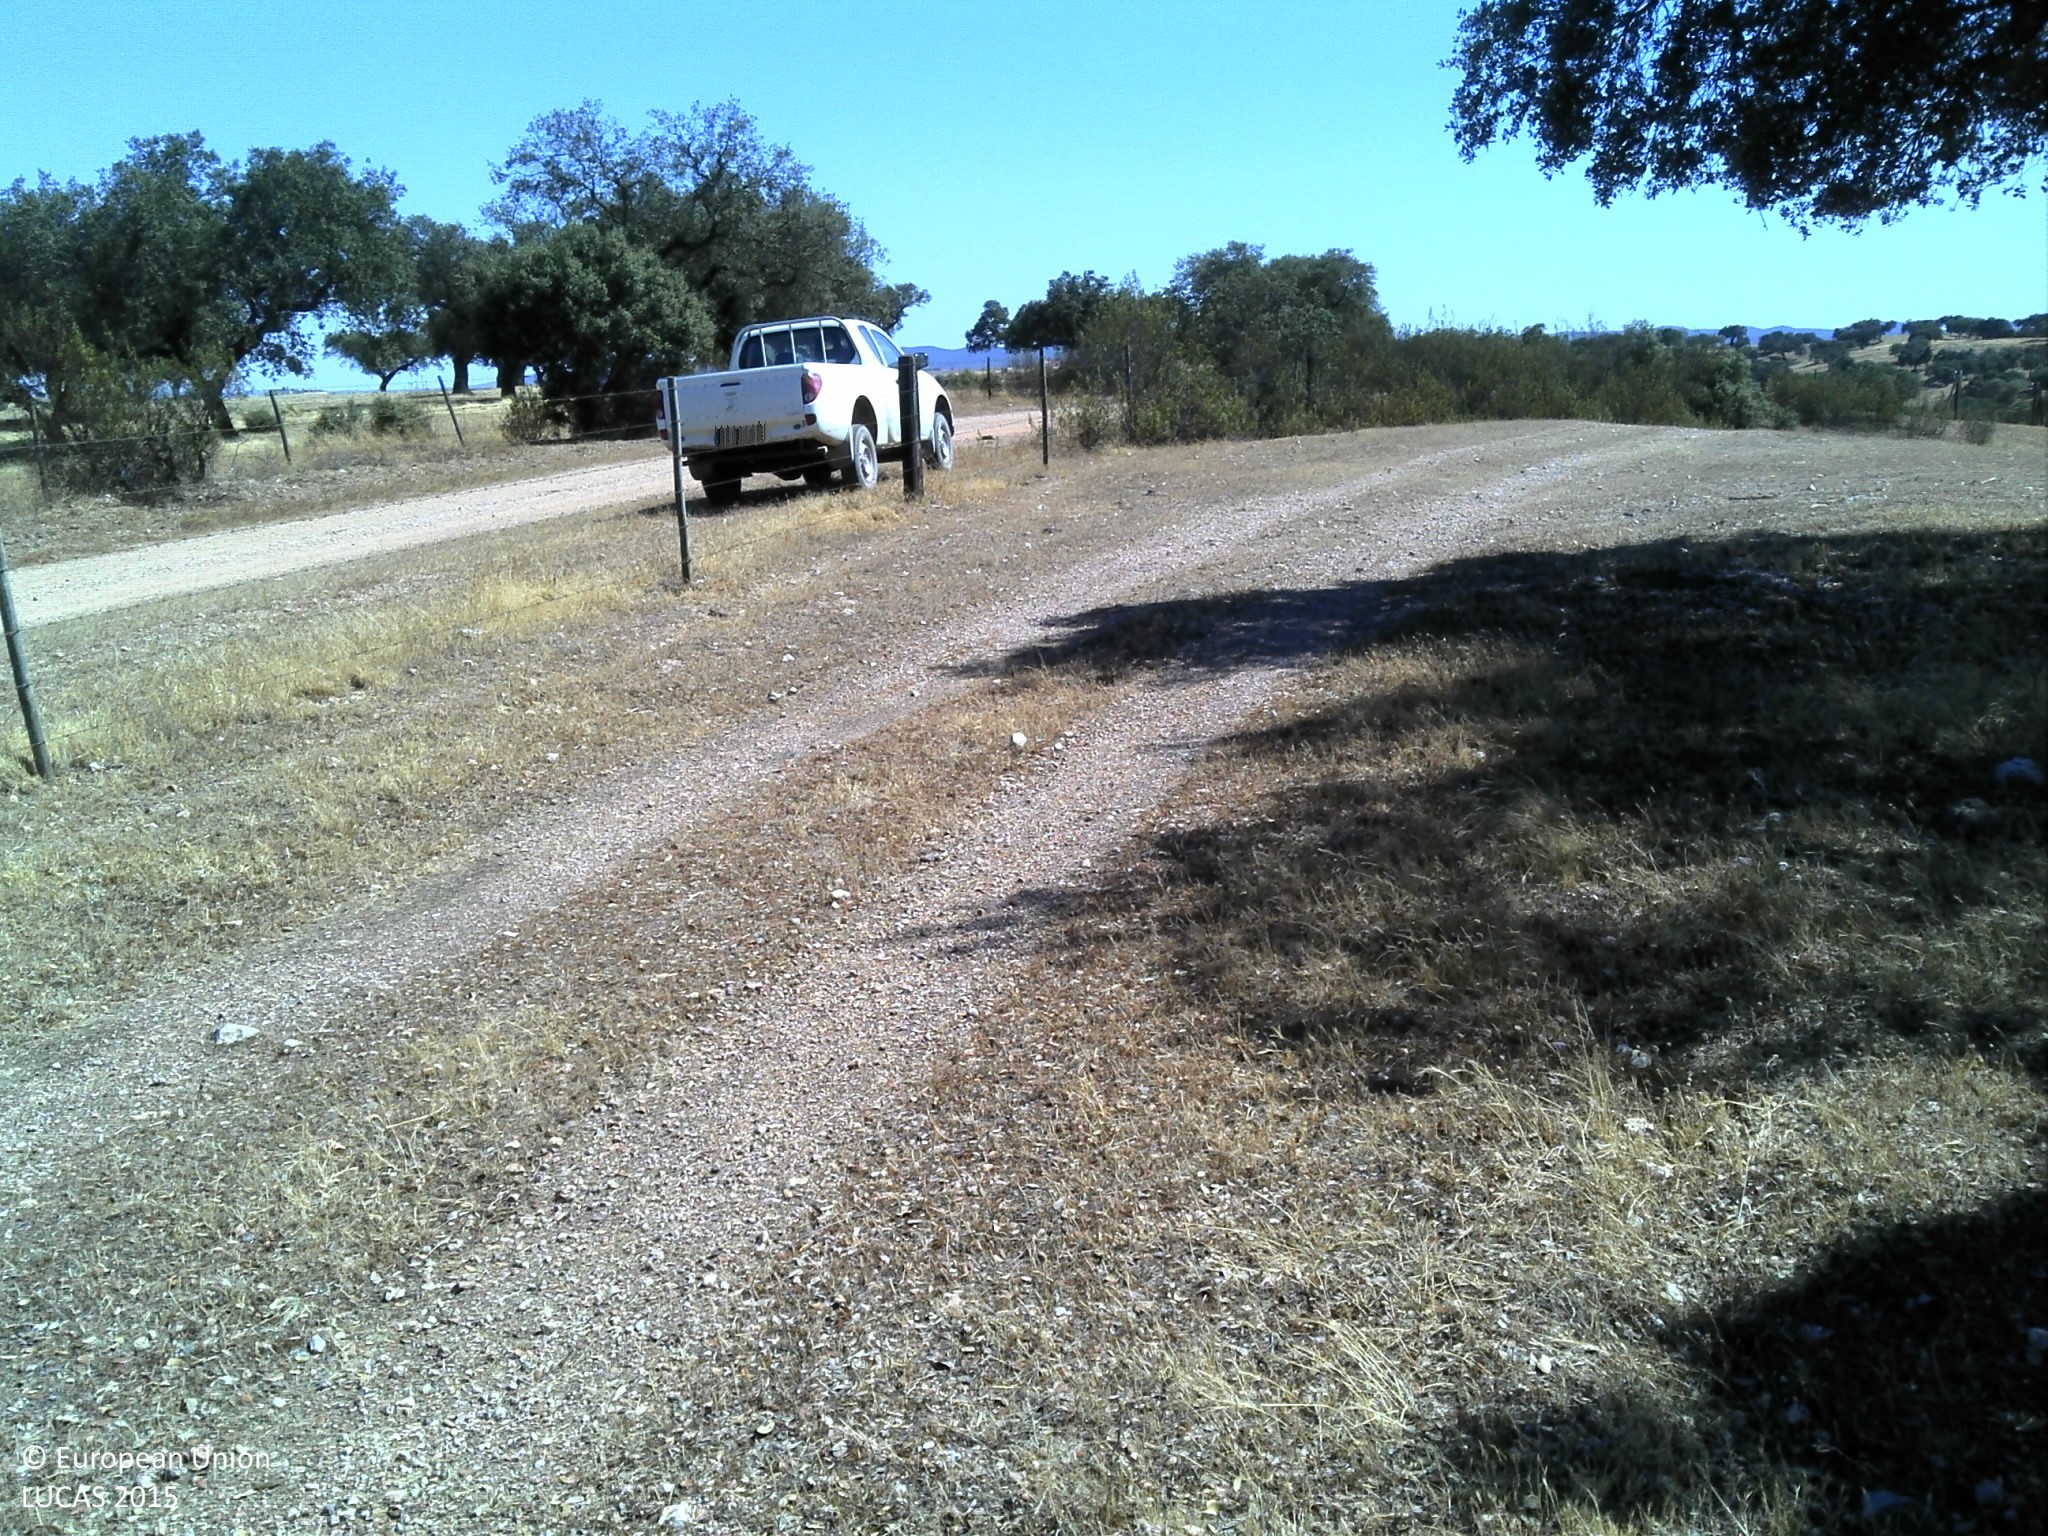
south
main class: Woodland
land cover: Broadleaved woodland
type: broadleaved evergreen forest
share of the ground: 25 - 50 %
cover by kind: broadleaved forest trees 45 %, unconsolidated bare surface 35 %, herbaceous plants 20 %
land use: Forestry
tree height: > 5 m
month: July
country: PT
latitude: 38.1576
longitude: -7.3311
